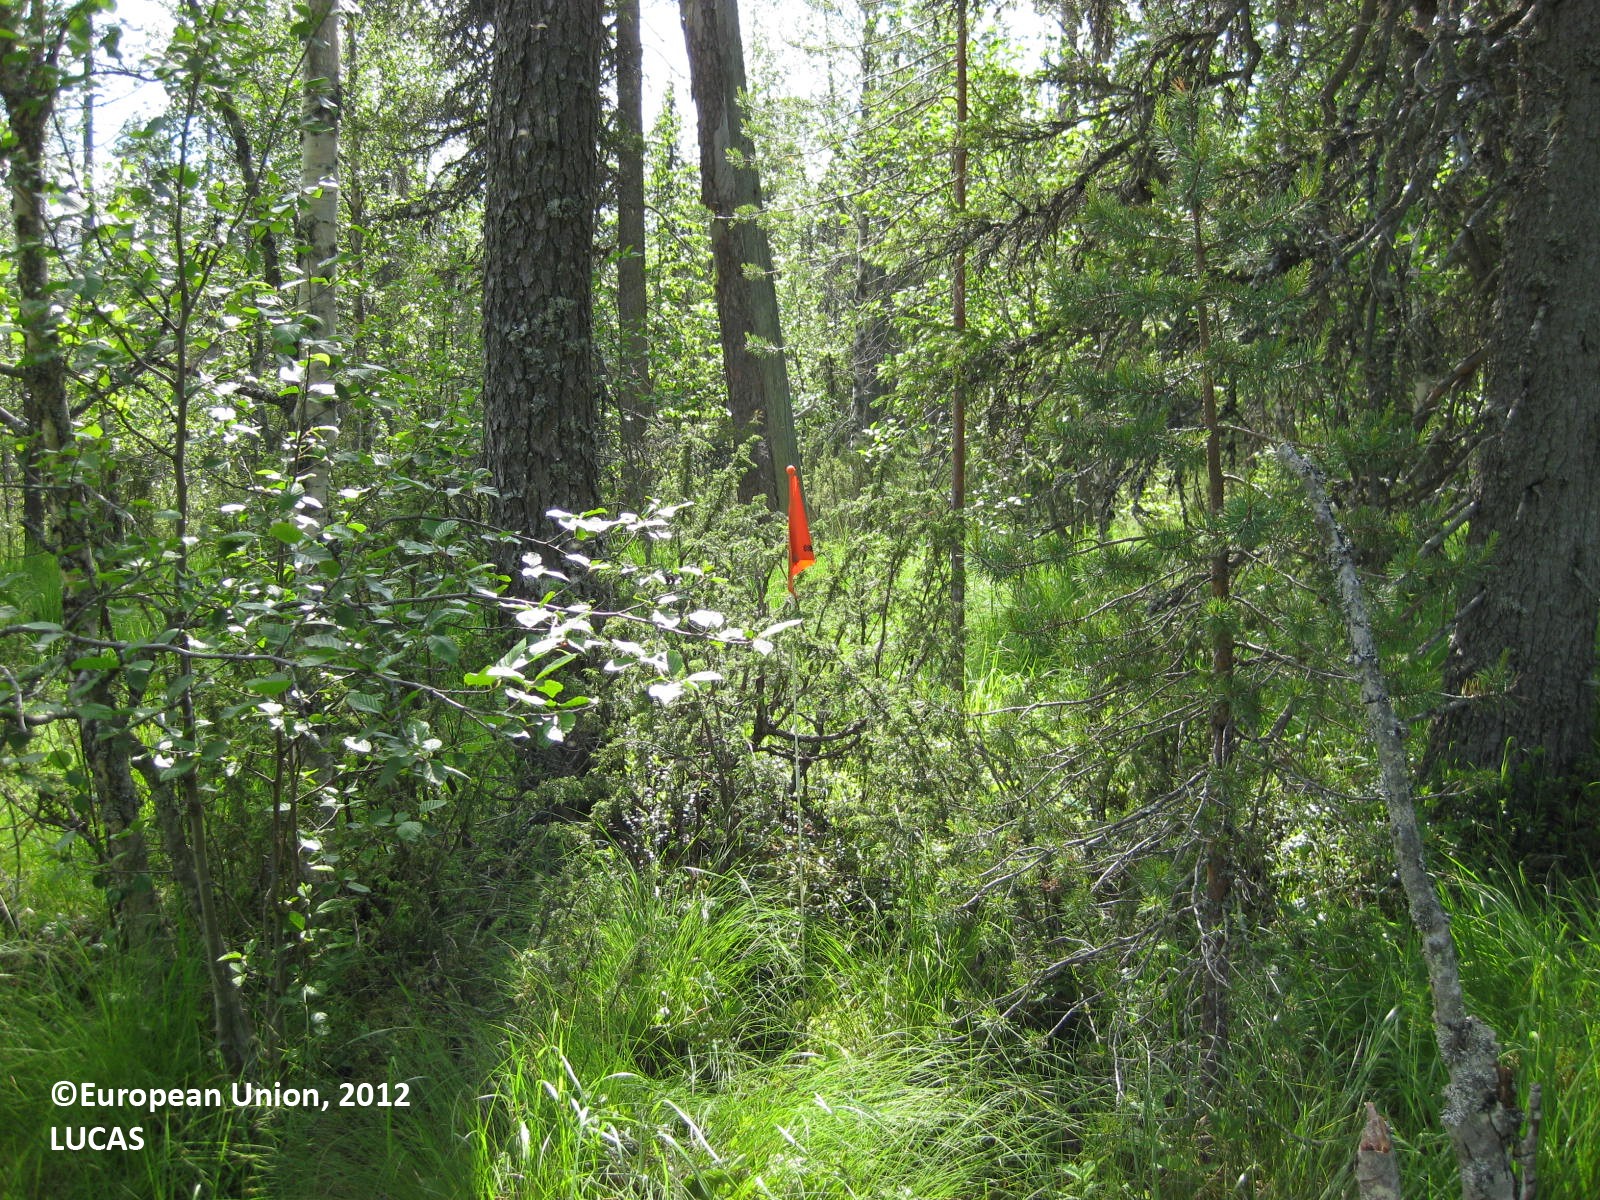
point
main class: Woodland
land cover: Pine dominated mixed woodland
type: boreal forest
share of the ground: > 75 %
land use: Semi-natural and natural areas not in use
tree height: > 5 m
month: July
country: FI
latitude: 65.5372
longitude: 29.3000
